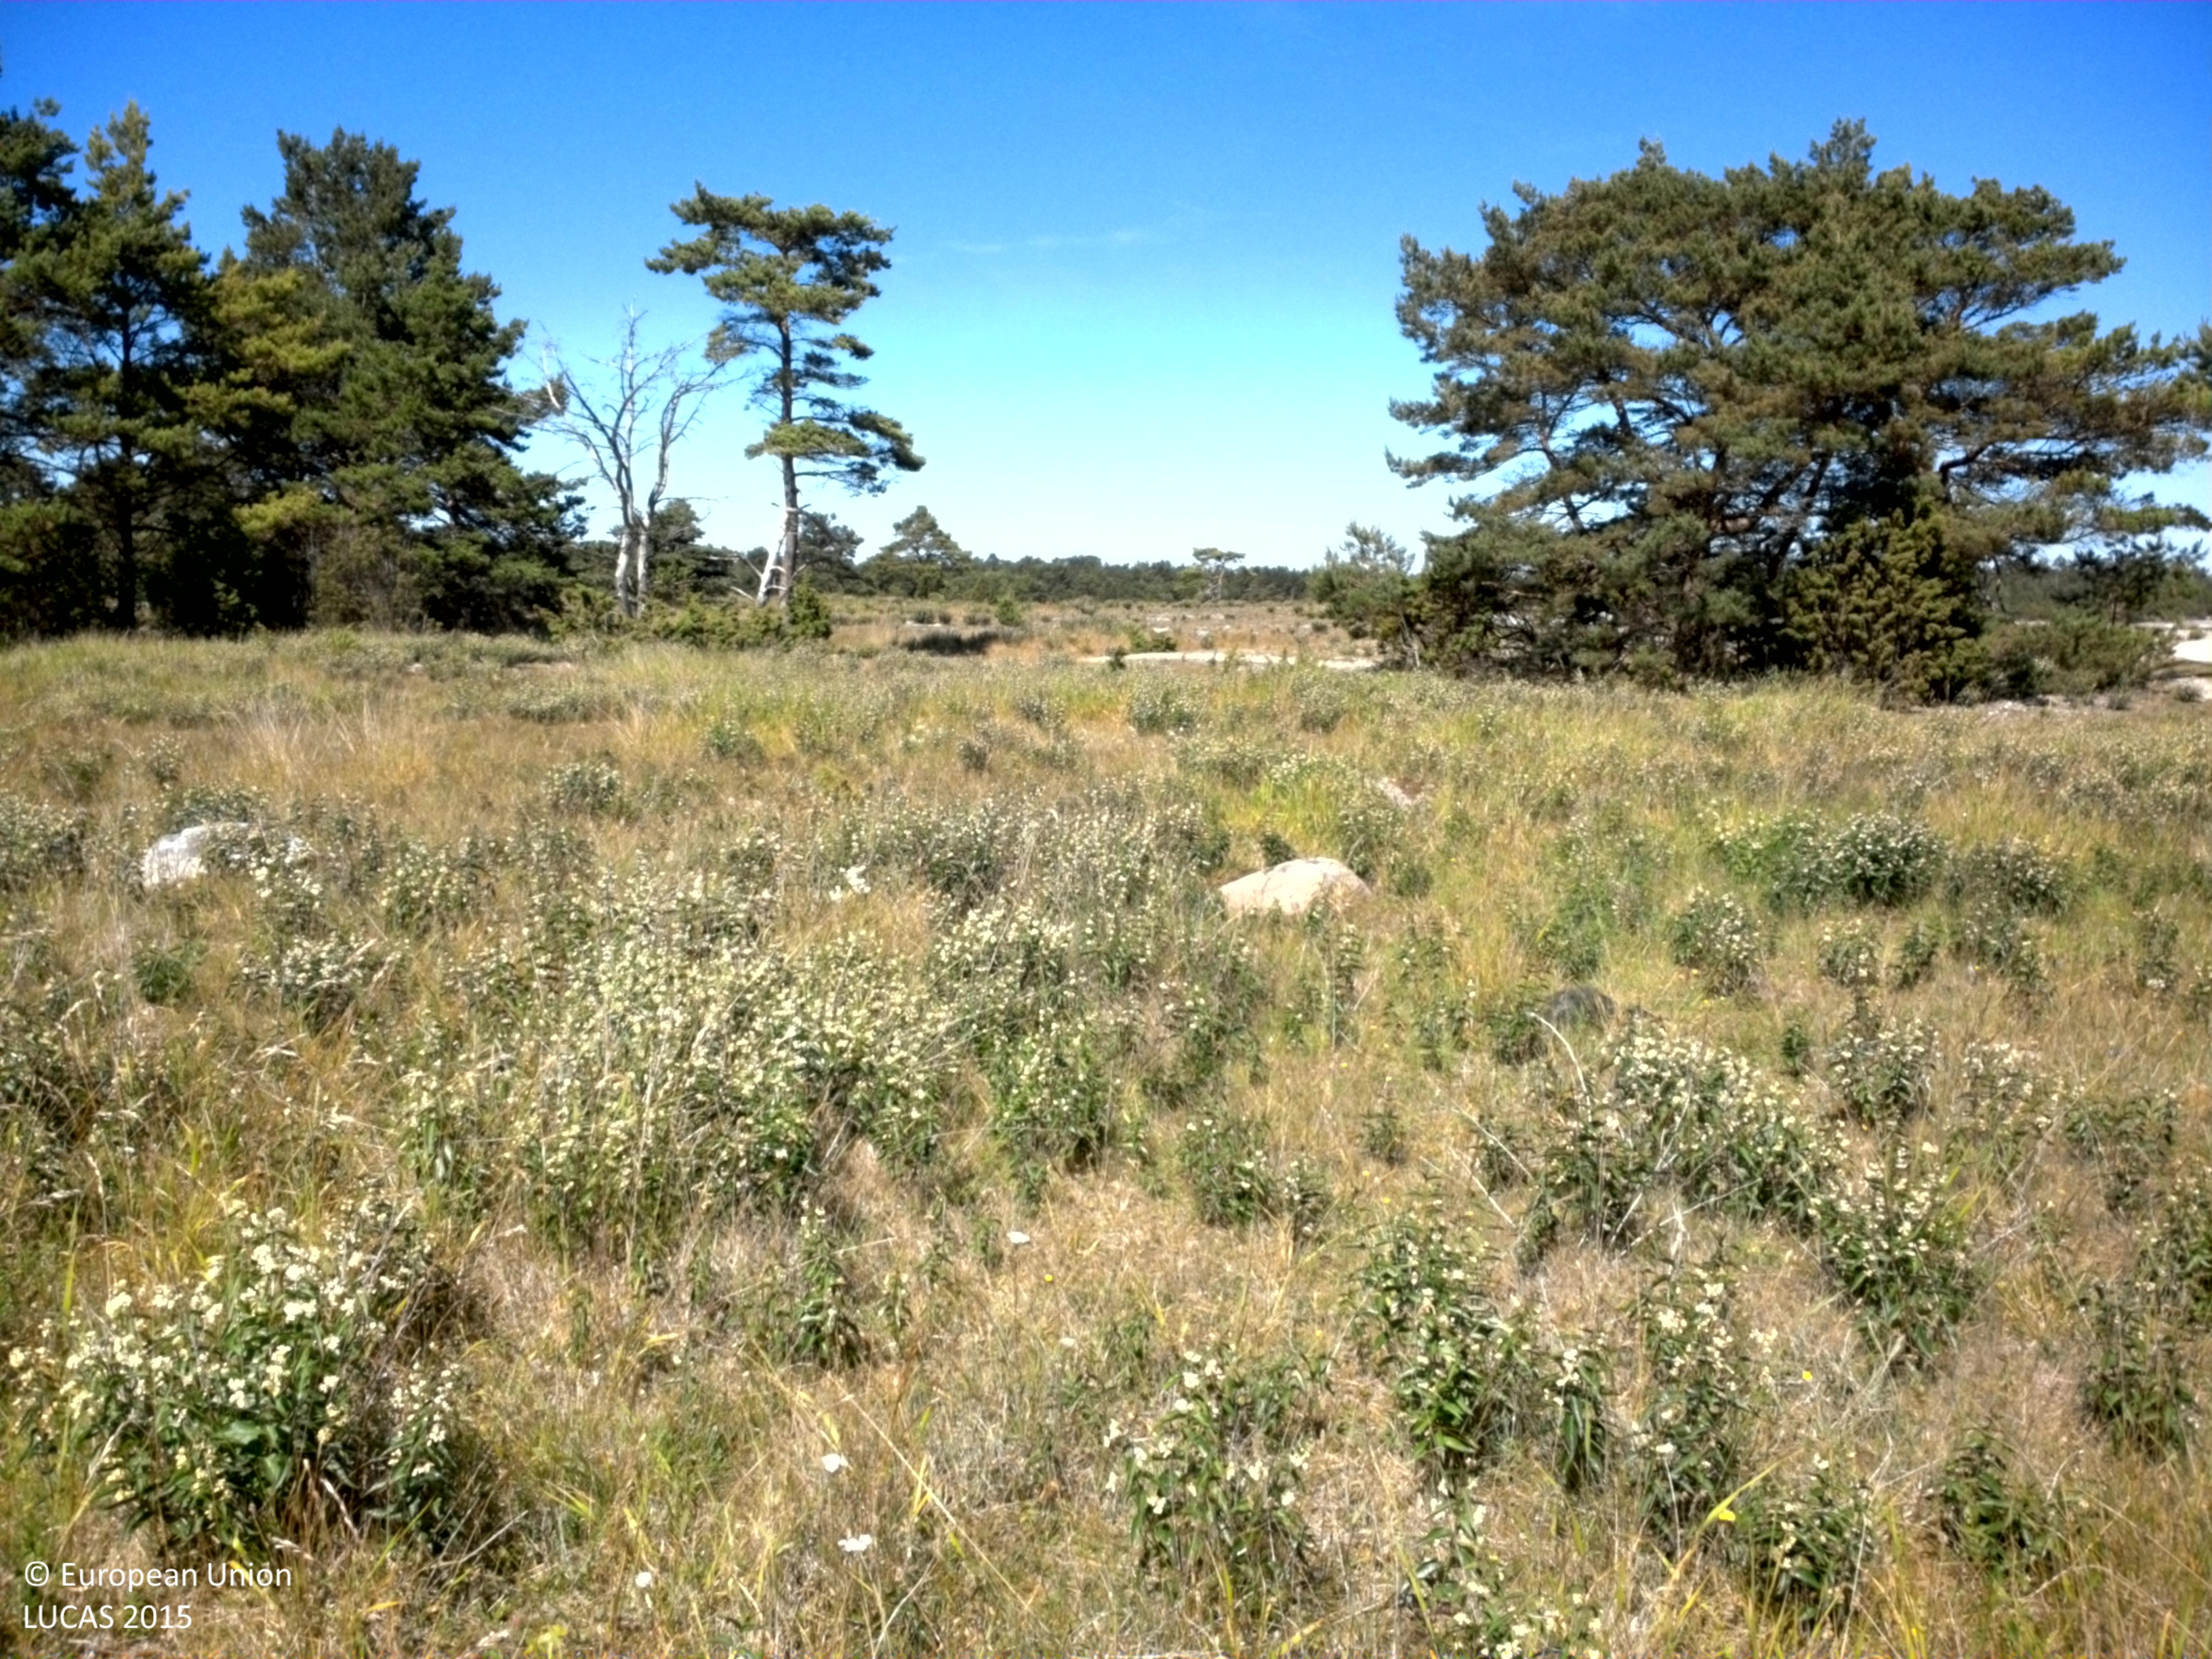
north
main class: Grassland
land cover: Grassland with sparse tree/shrub cover
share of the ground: > 75 %
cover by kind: herbaceous plants 95 %, coniferous forest trees 5 %
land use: Amenities, museums, leisure
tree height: > 5 m
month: July
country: SE
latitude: 57.8541
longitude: 19.1280
